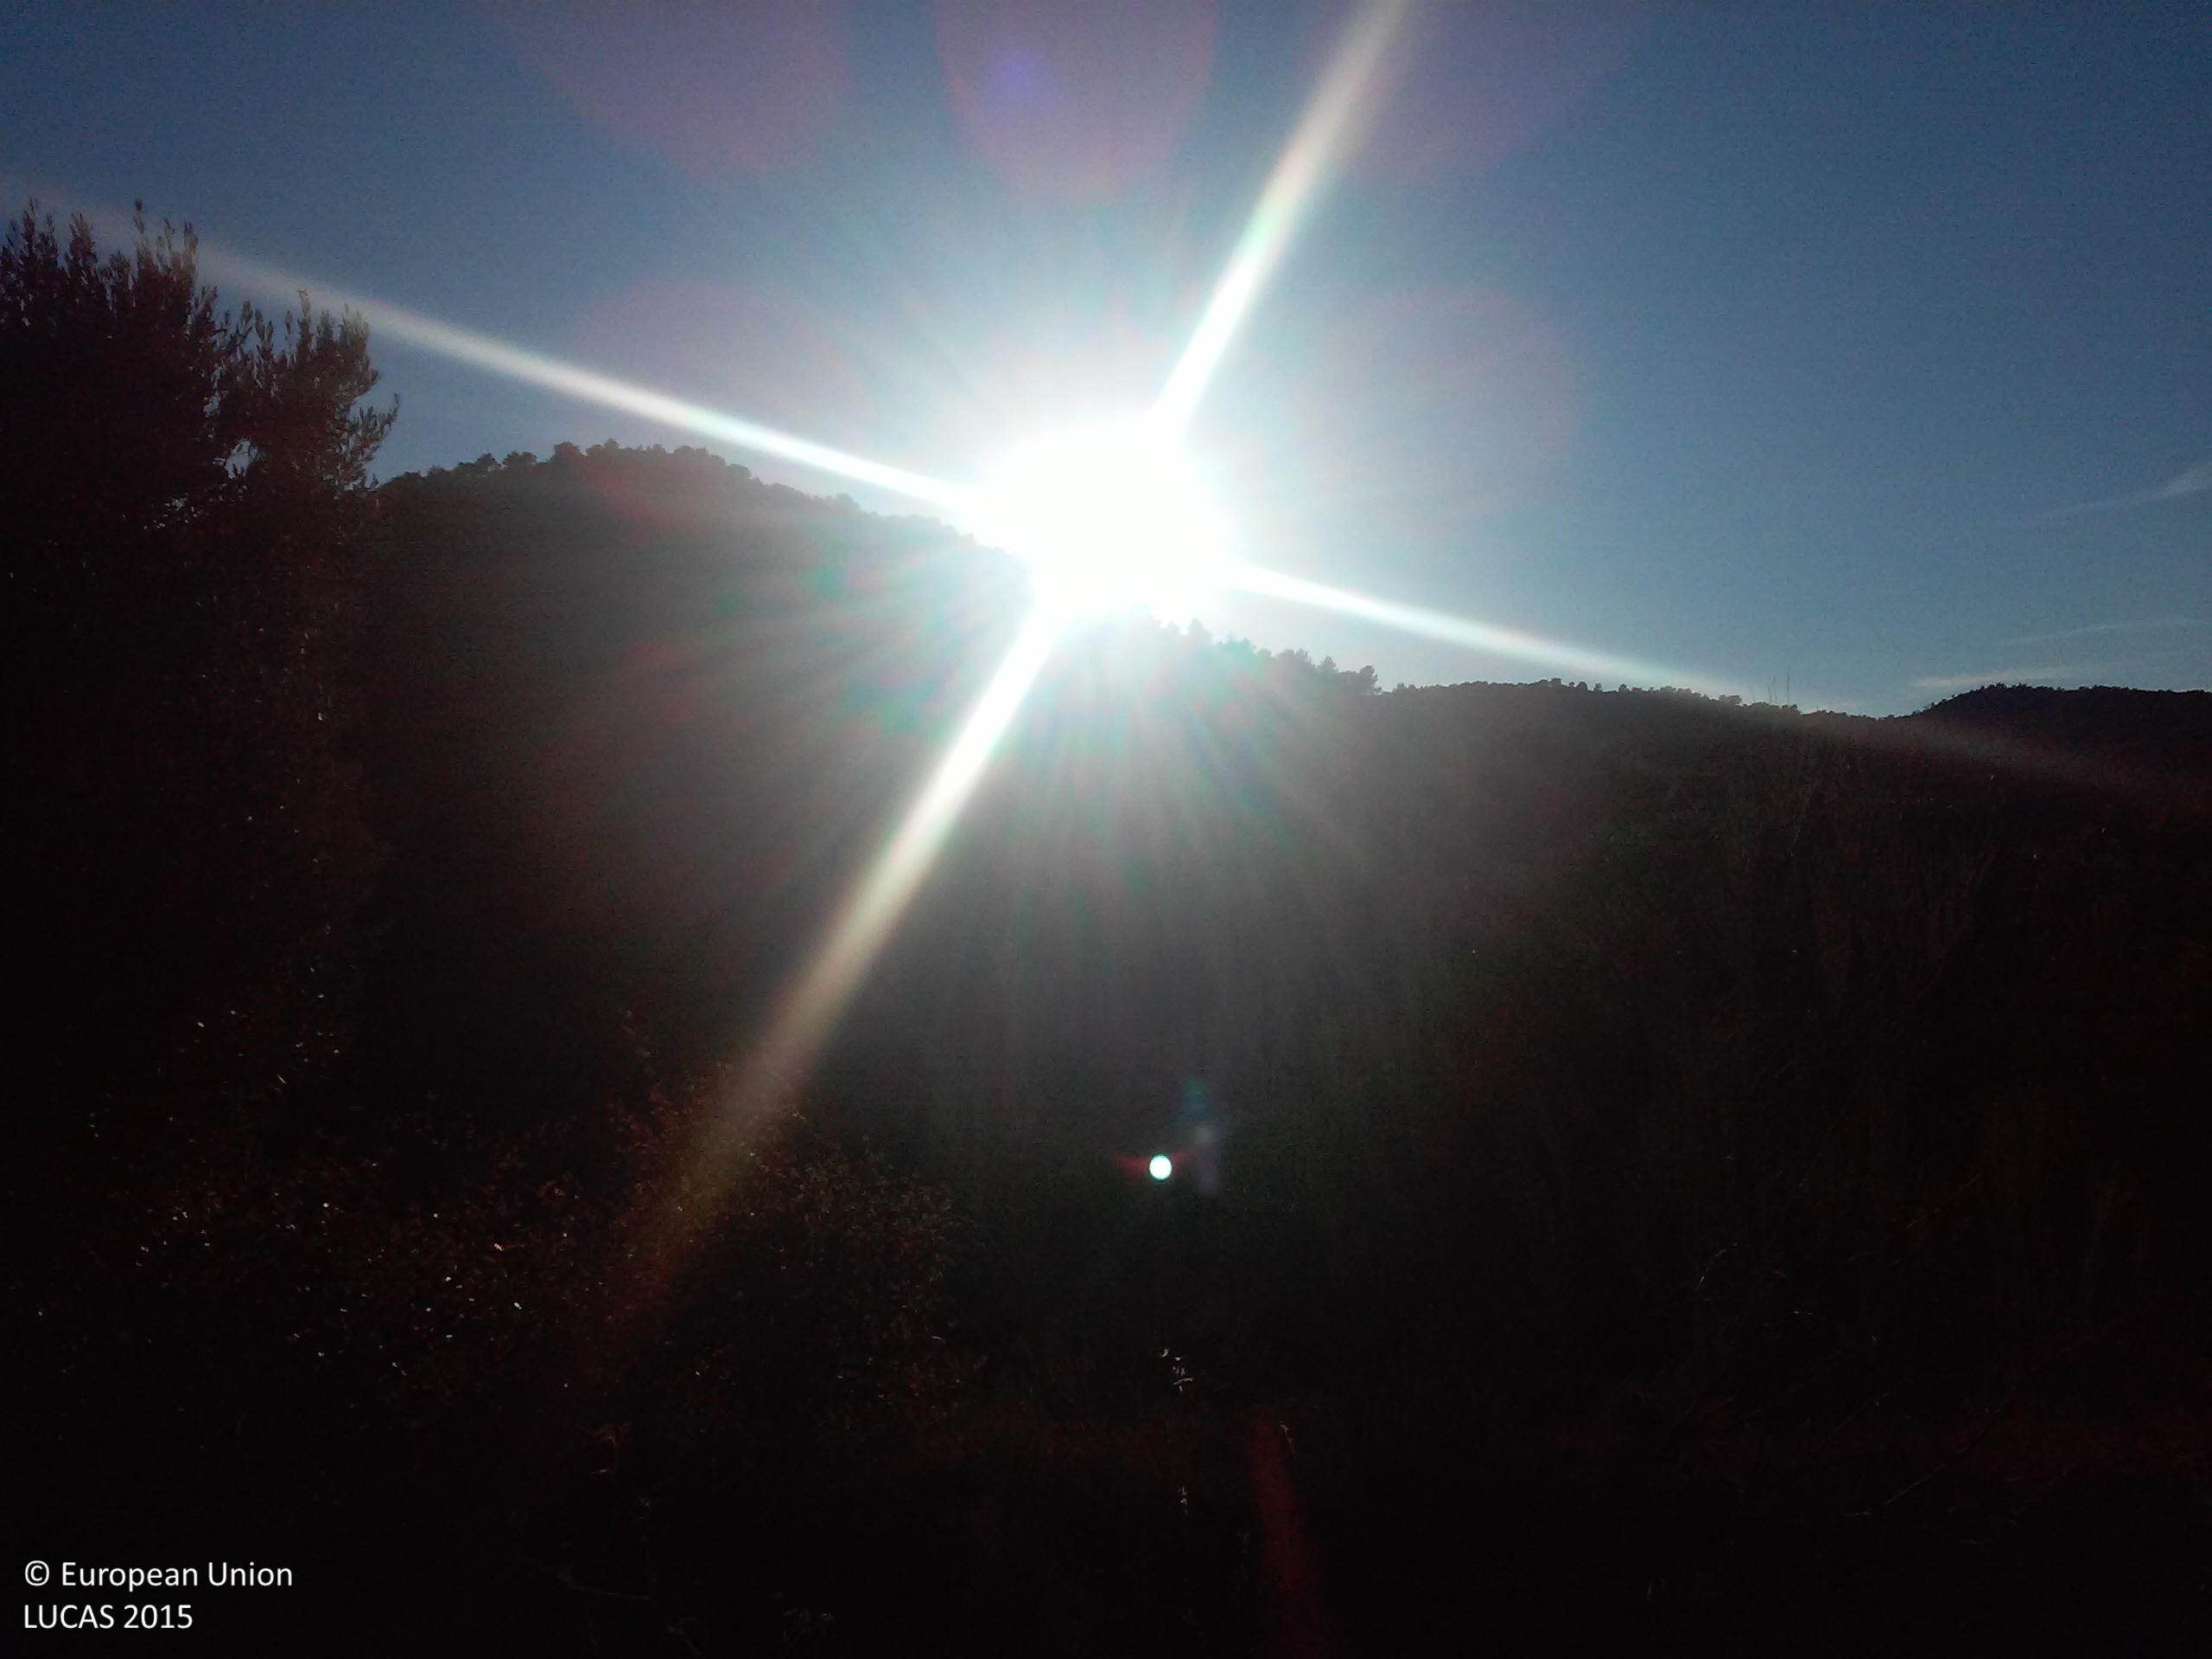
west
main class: Cropland
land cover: Olive groves
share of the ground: 10 - 25 %
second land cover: Grassland without tree/shrub cover
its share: > 75 %
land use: Agriculture (excluding fallow land and kitchen gardens)
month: August
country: ES
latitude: 41.2815
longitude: 0.5219
